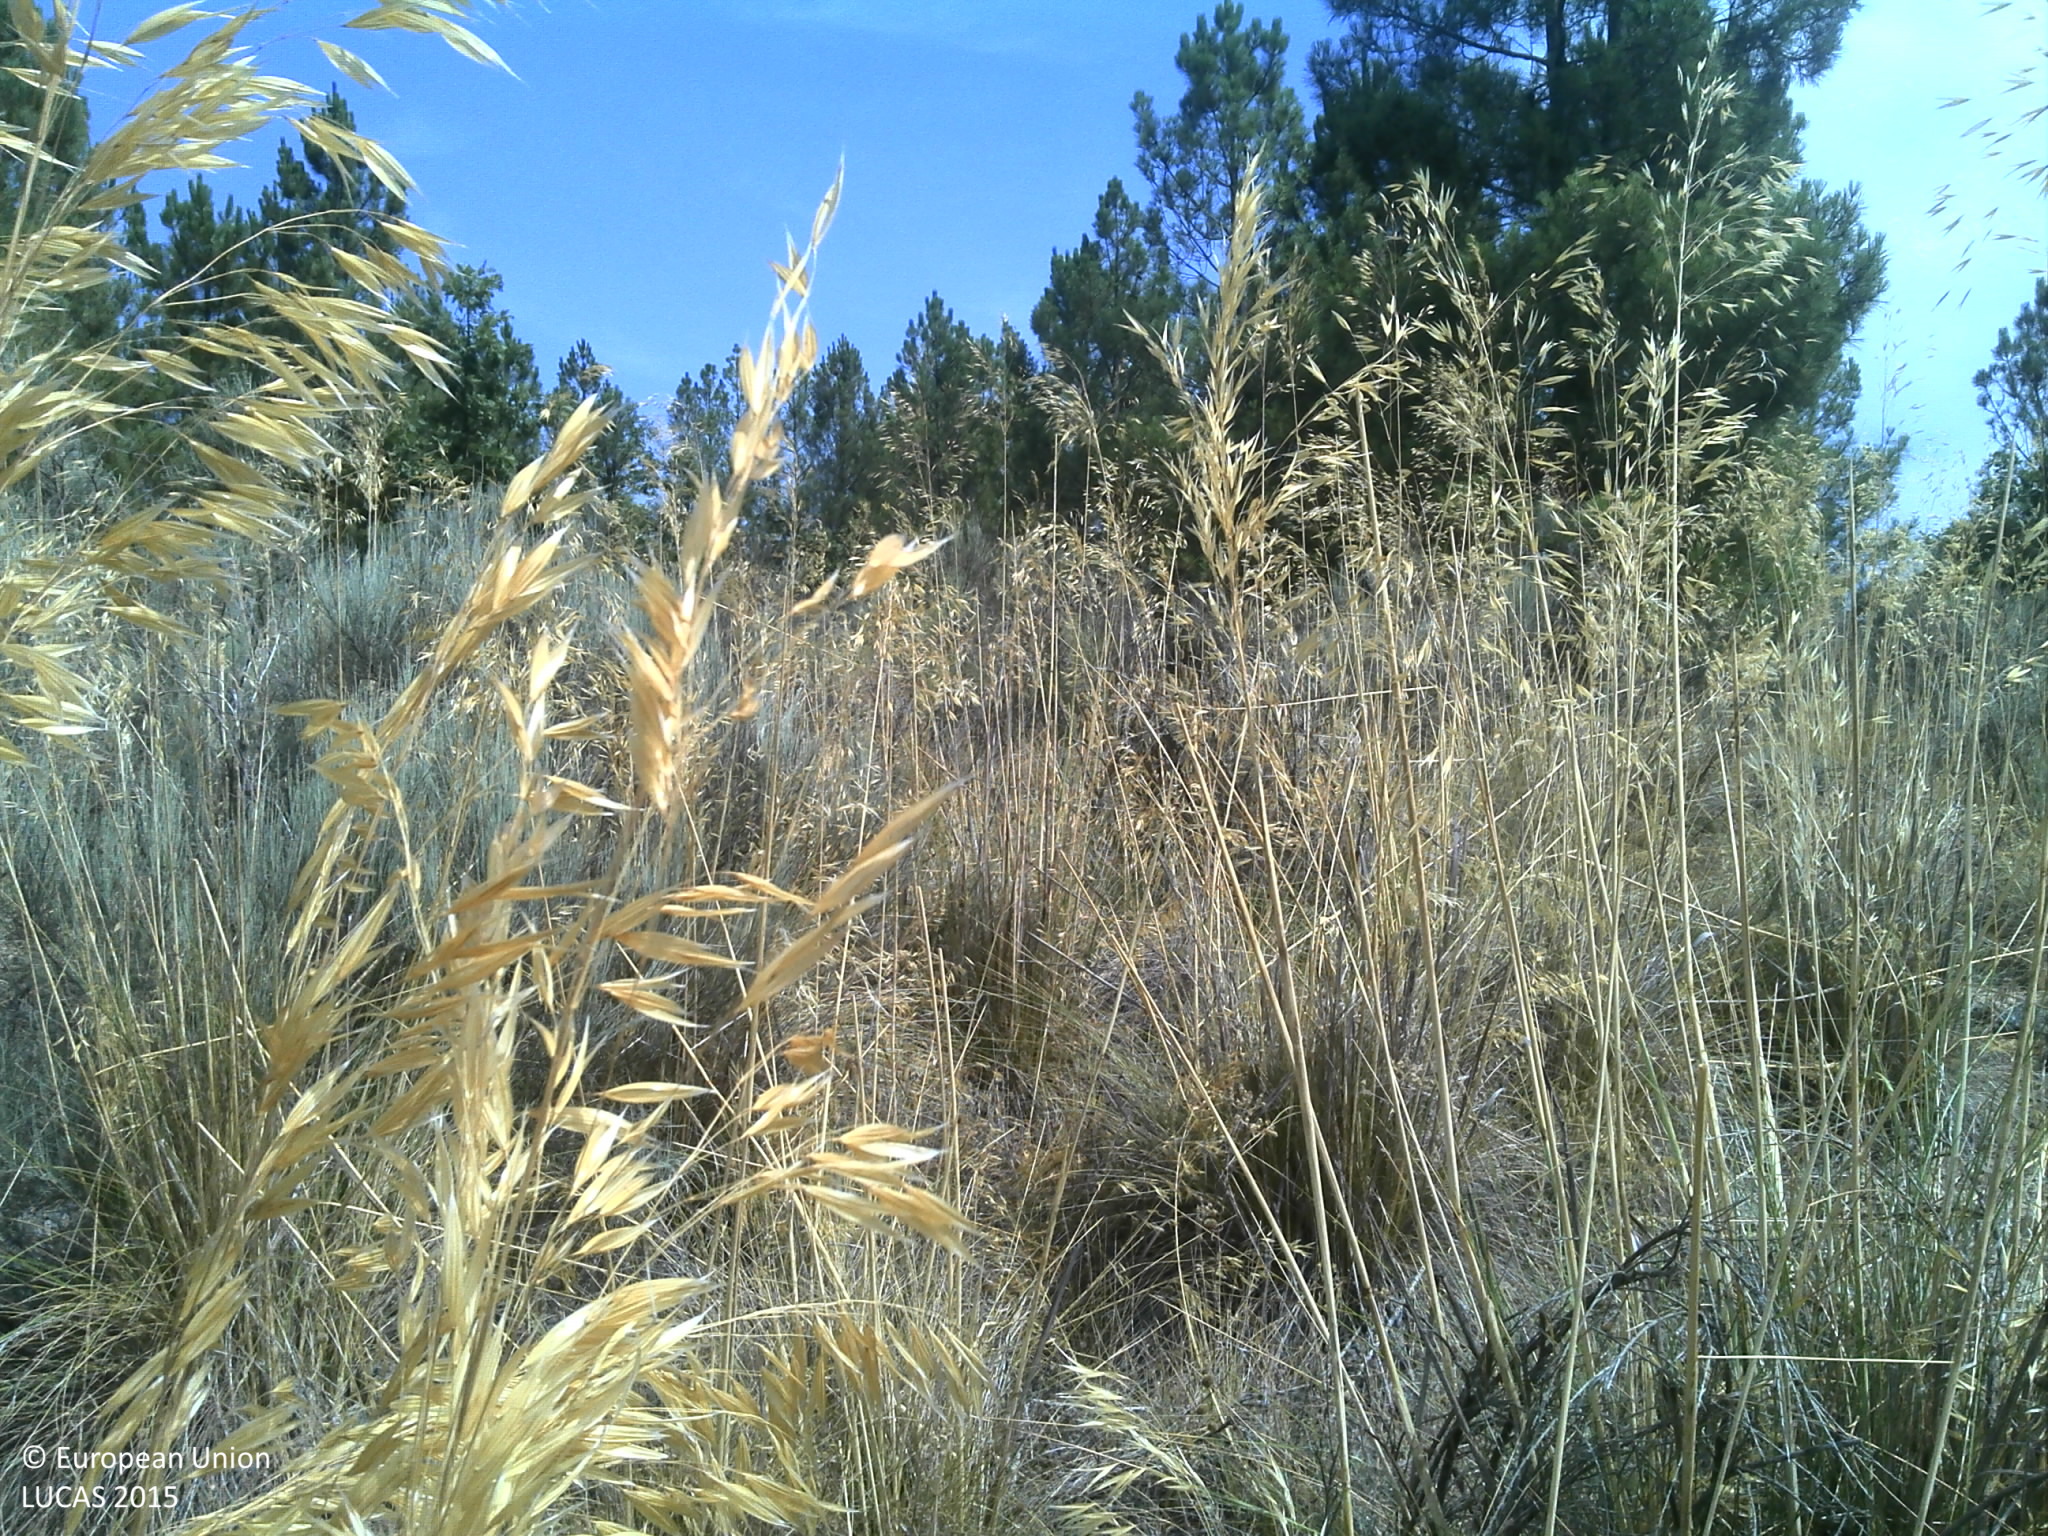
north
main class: Shrubland
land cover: Shrubland with sparse tree cover
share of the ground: > 75 %
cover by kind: shrubs 75 %, unconsolidated bare surface 10 %, broadleaved forest trees 5 %, herbaceous plants 5 %, consolidated bare surface 5 %
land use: Semi-natural and natural areas not in use
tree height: > 5 m
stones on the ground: > 50 %
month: July
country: PT
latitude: 40.9012
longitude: -7.3624
